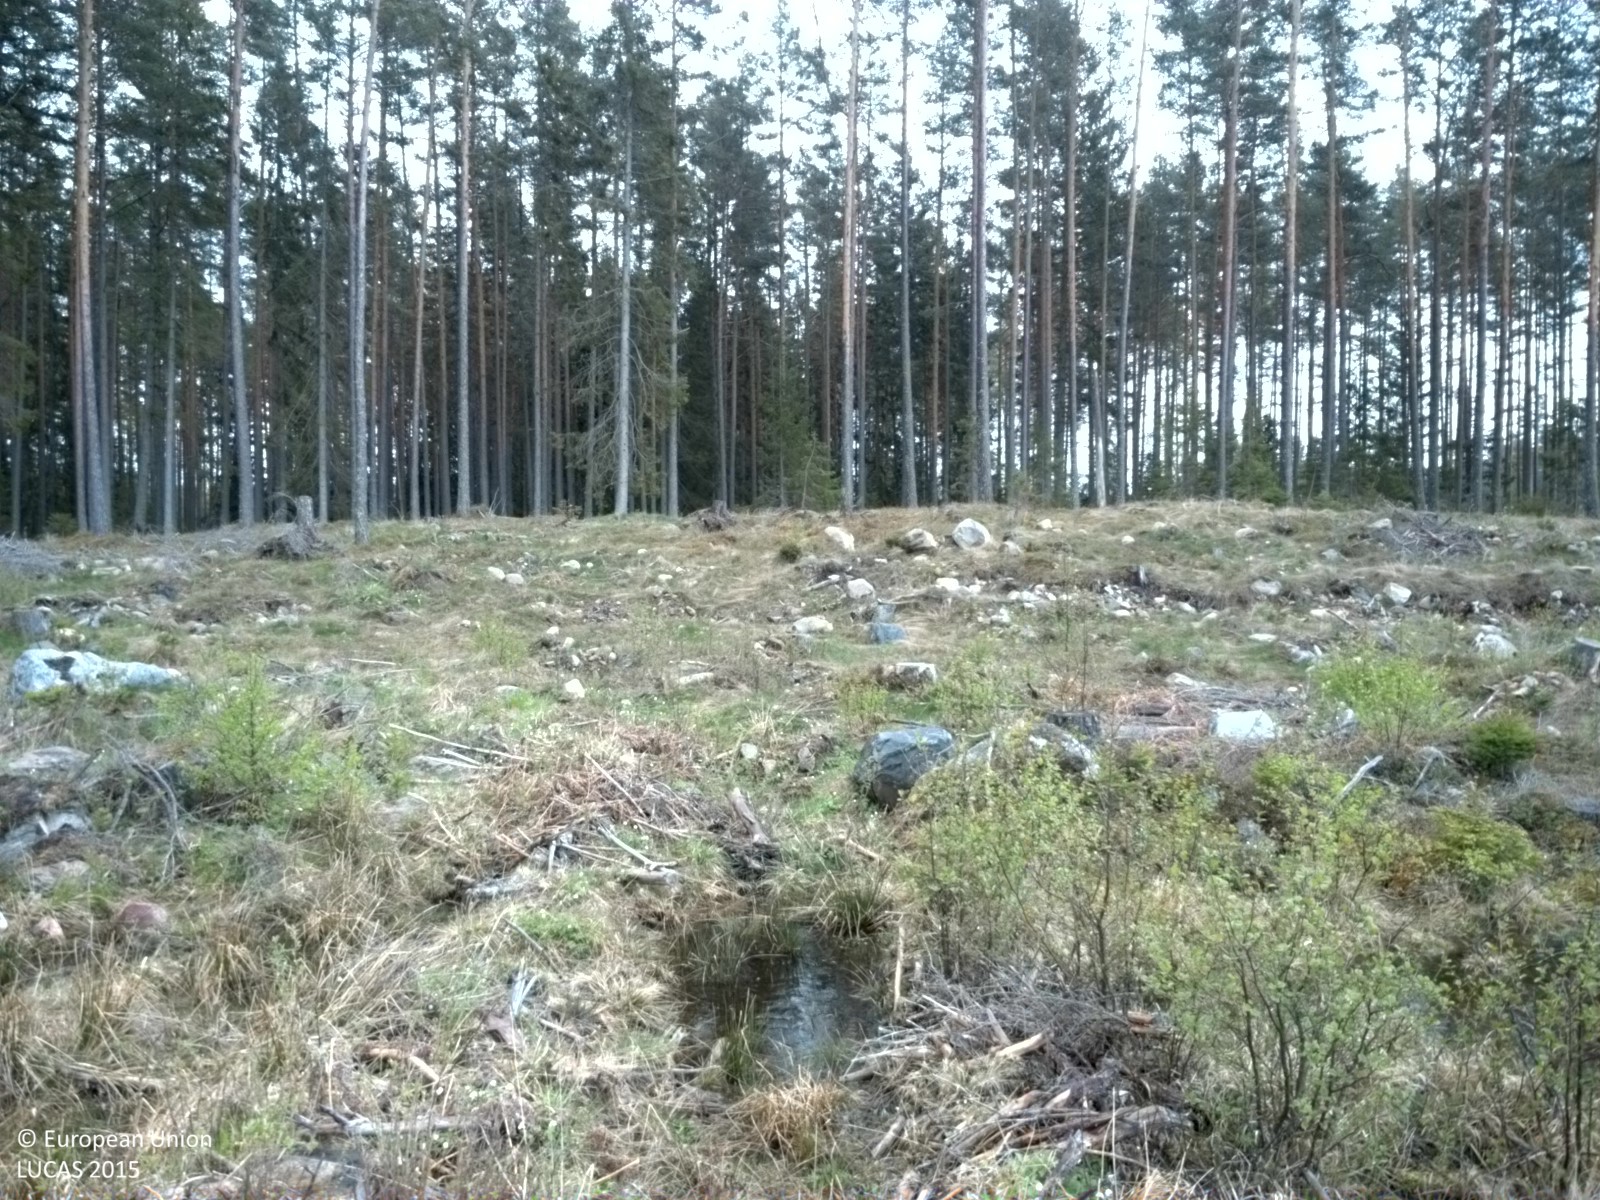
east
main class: Grassland
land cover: Grassland with sparse tree/shrub cover
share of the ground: 50 - 75 %
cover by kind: herbaceous plants 60 %, shrubs 10 %, coniferous forest trees 5 %
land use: Forestry
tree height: > 5 m
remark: Clear cut
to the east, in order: Grassland with sparse tree/shrub cover; Pine dominated coniferous woodland; Spruce dominated coniferous woodland; Spruce dominated mixed woodland
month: May
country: SE
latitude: 60.1718
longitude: 17.9788
